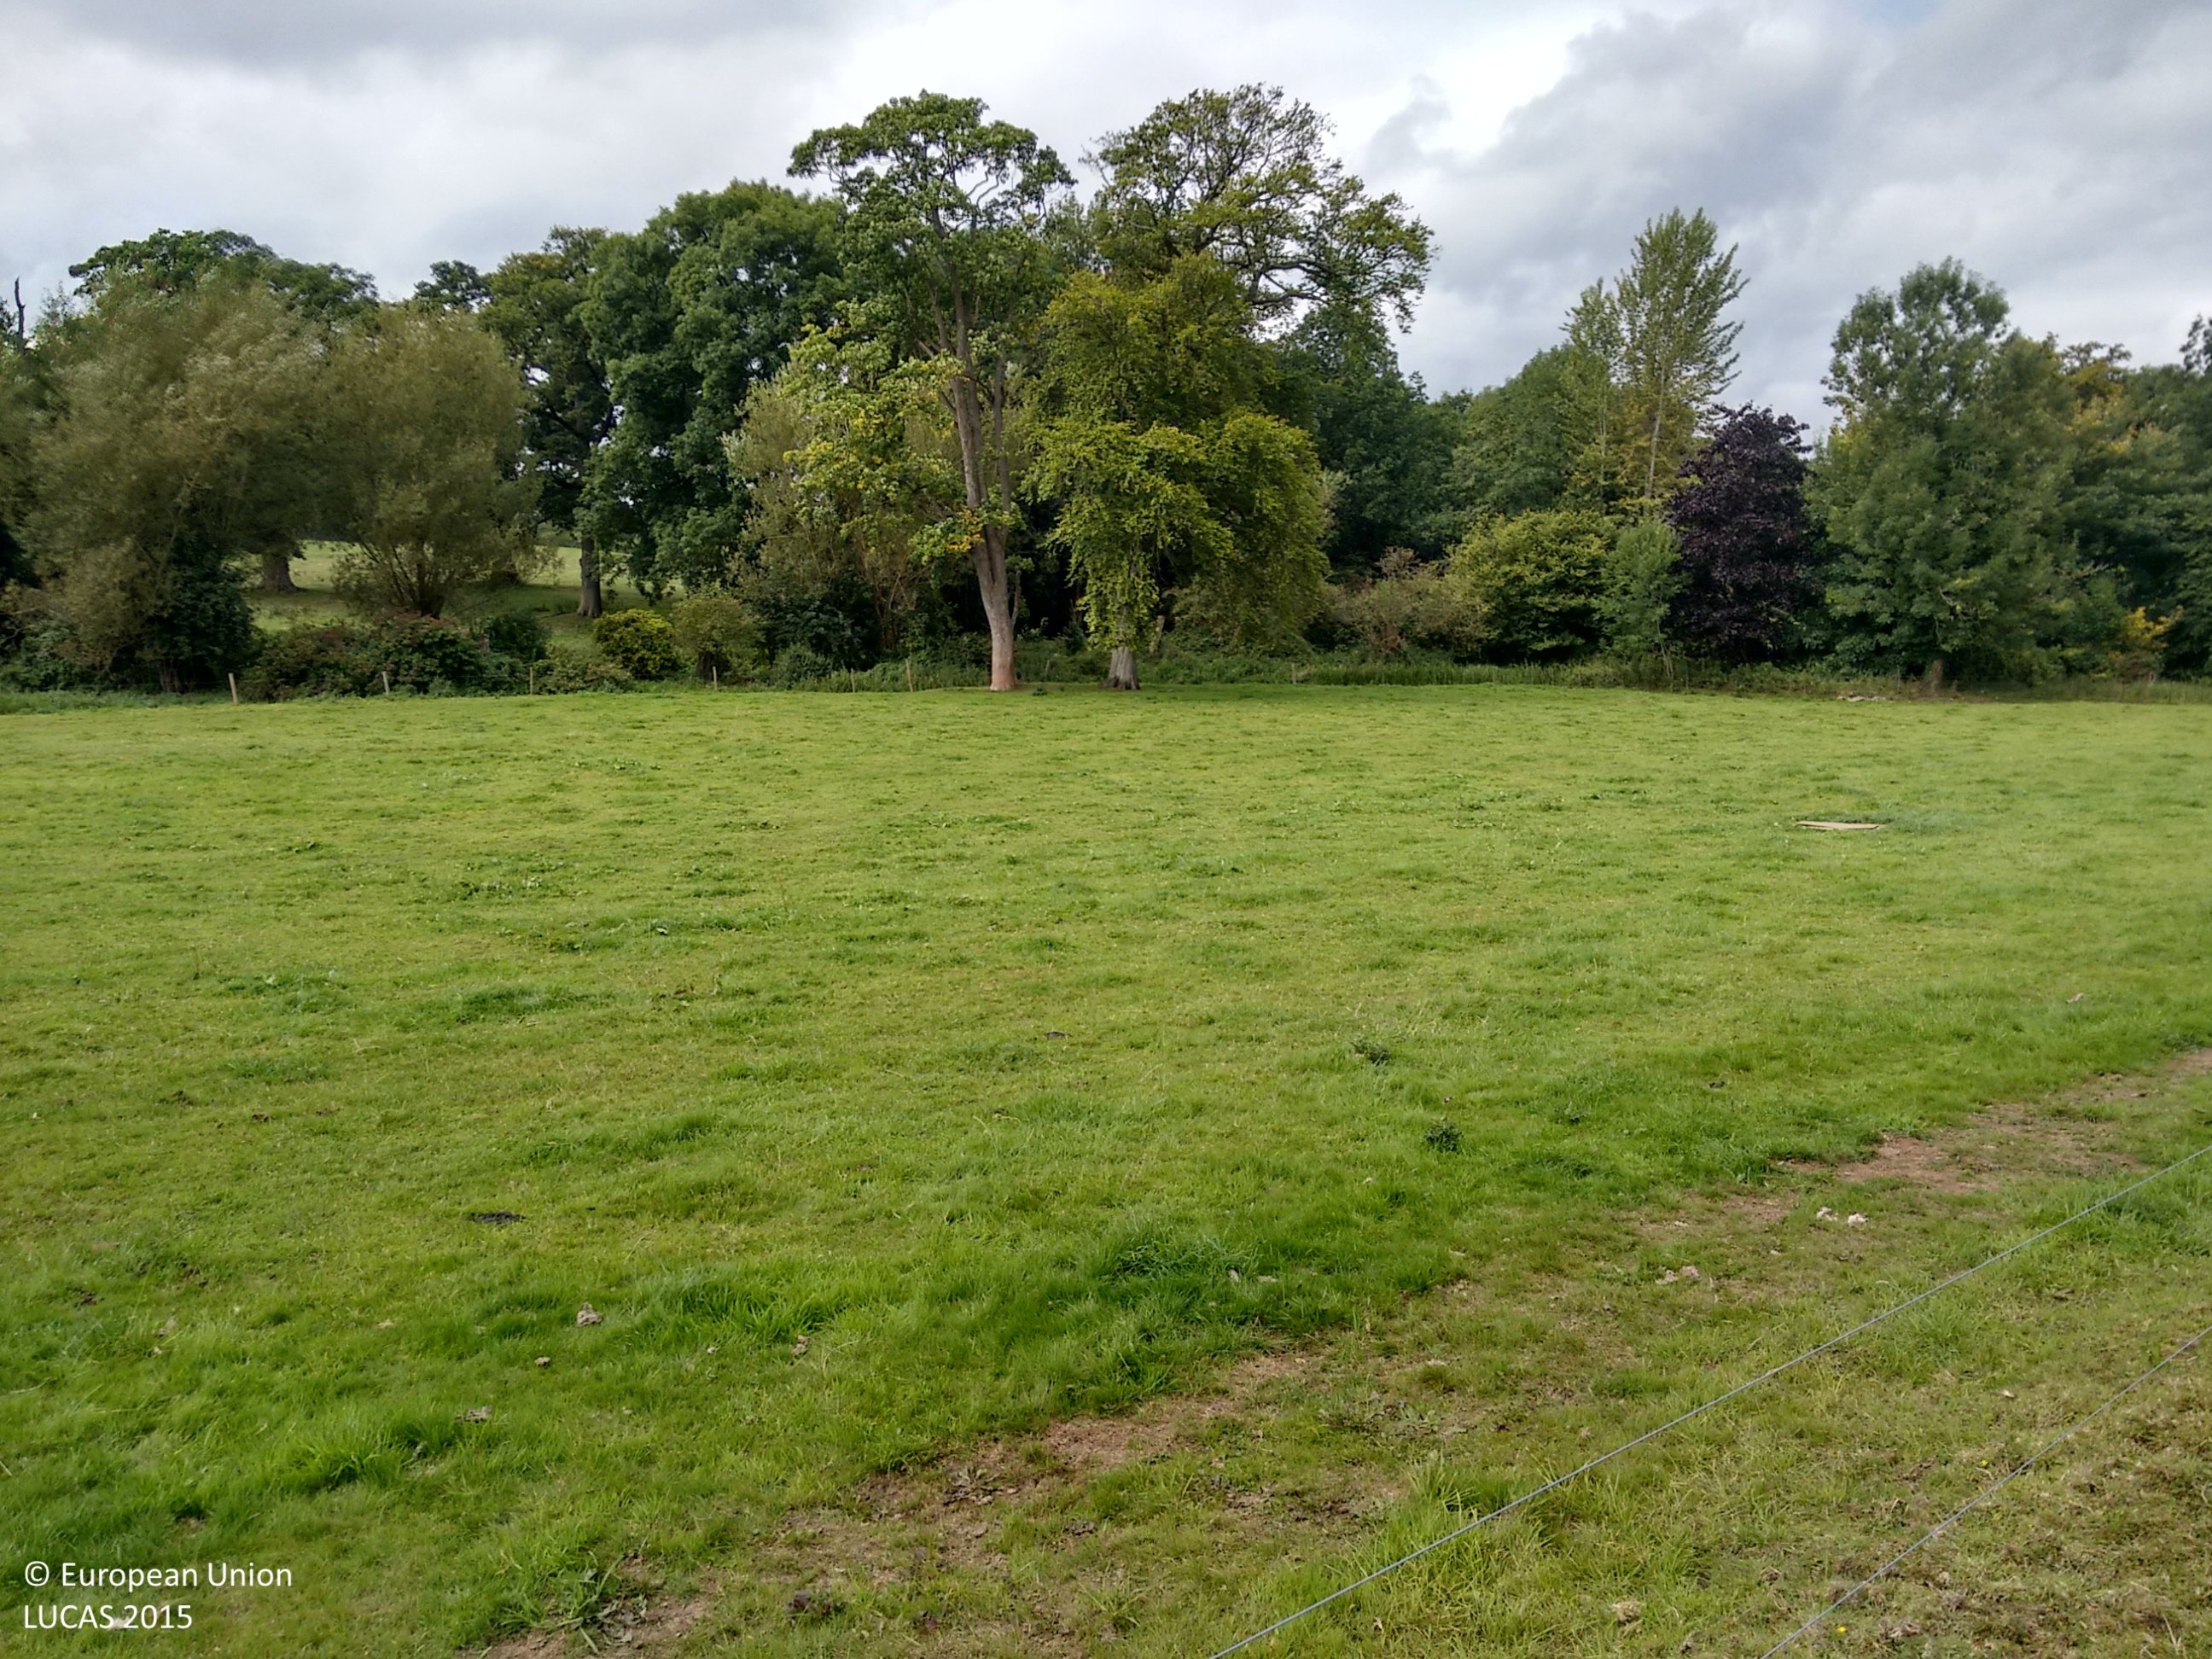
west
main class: Grassland
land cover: Grassland without tree/shrub cover
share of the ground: > 75 %
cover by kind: herbaceous plants 100 %
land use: Agriculture (excluding fallow land and kitchen gardens)
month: September
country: GB
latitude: 52.8809
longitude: -2.9876
